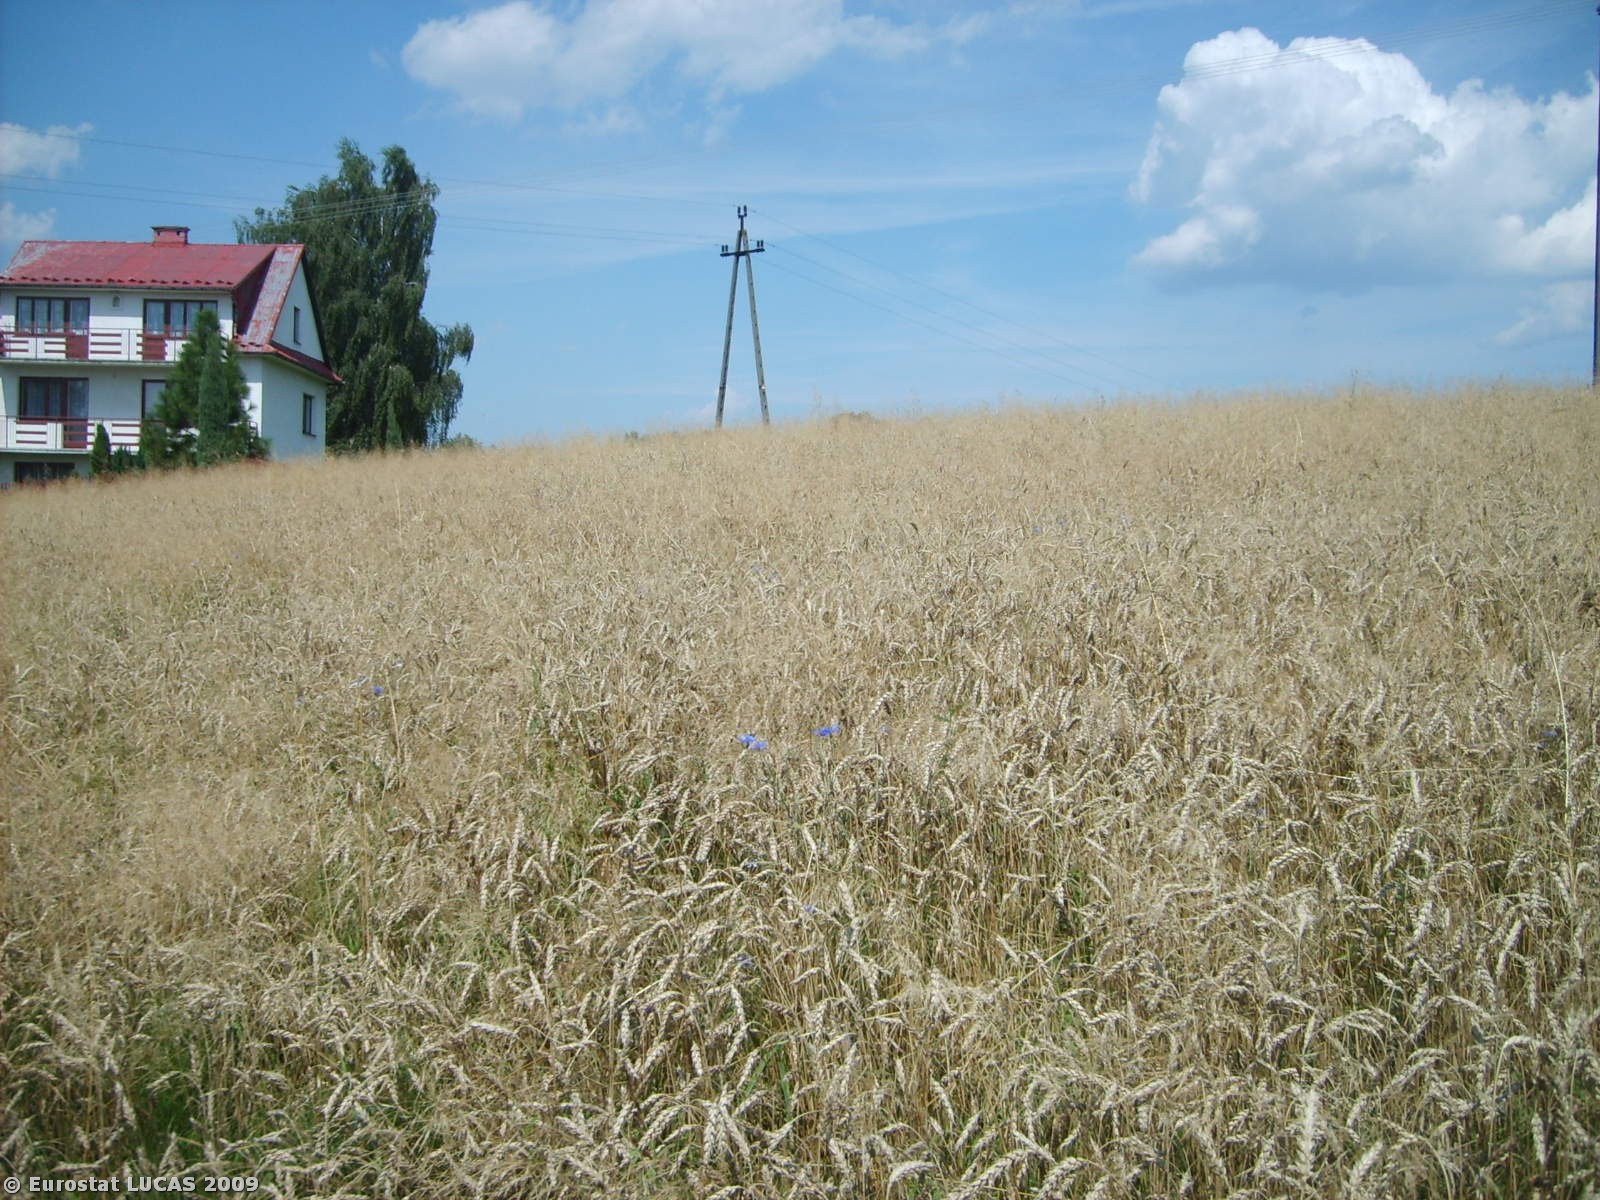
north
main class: Cropland
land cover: Common wheat
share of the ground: > 75 %
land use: Agriculture (excluding fallow land and kitchen gardens)
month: July
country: PL
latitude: 49.8701
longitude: 20.5989
